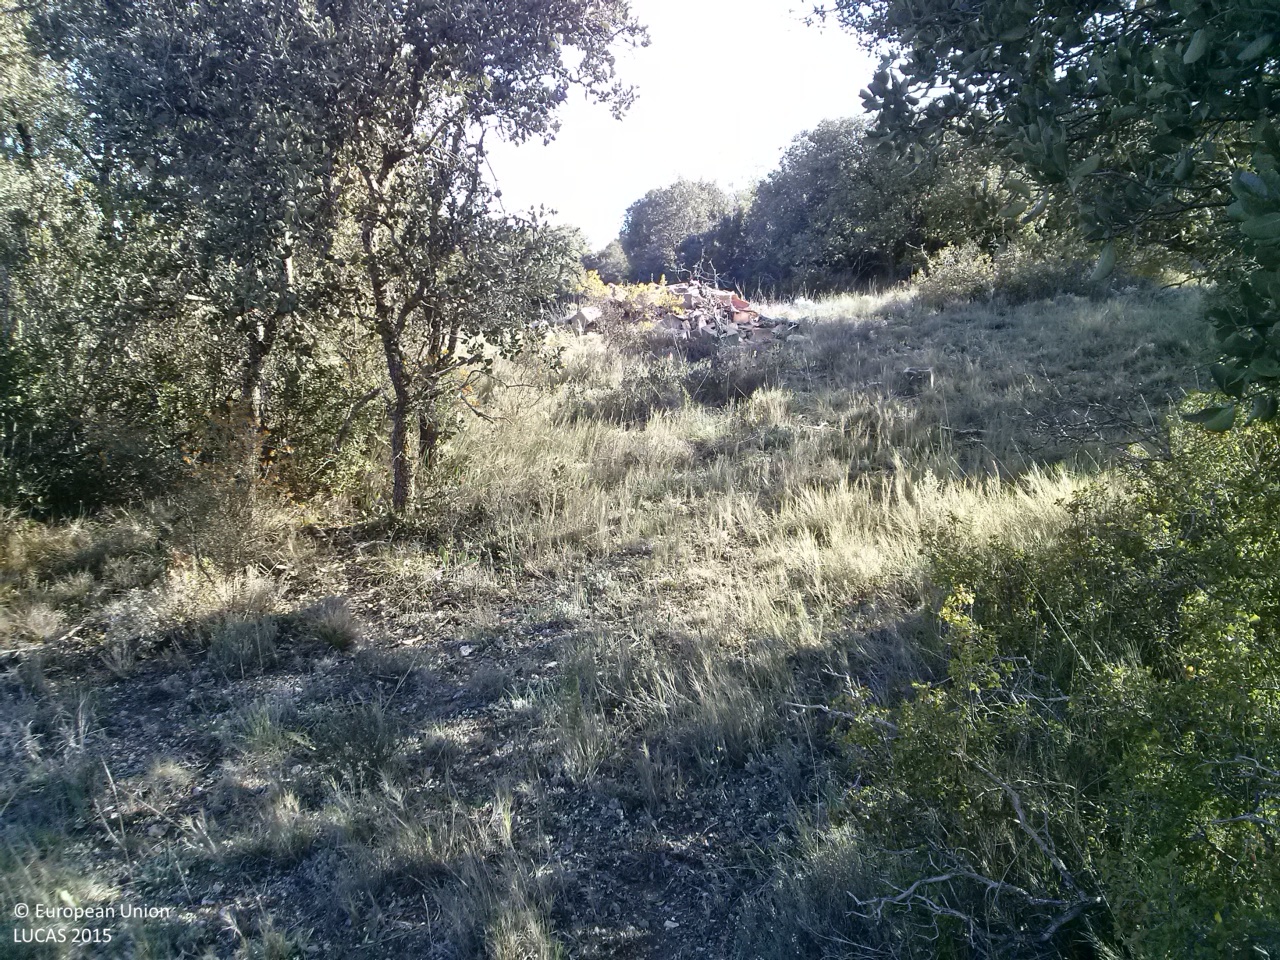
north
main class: Woodland
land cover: Broadleaved woodland
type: broadleaved evergreen forest
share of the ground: 25 - 50 %
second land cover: Grassland without tree/shrub cover
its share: 25 - 50 %
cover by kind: broadleaved forest trees 45 %, herbaceous plants 30 %, unconsolidated bare surface 20 %, shrubs 5 %
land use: Forestry
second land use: Agriculture (excluding fallow land and kitchen gardens)
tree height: < 5 m
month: May
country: ES
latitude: 39.9033
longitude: -2.7812
